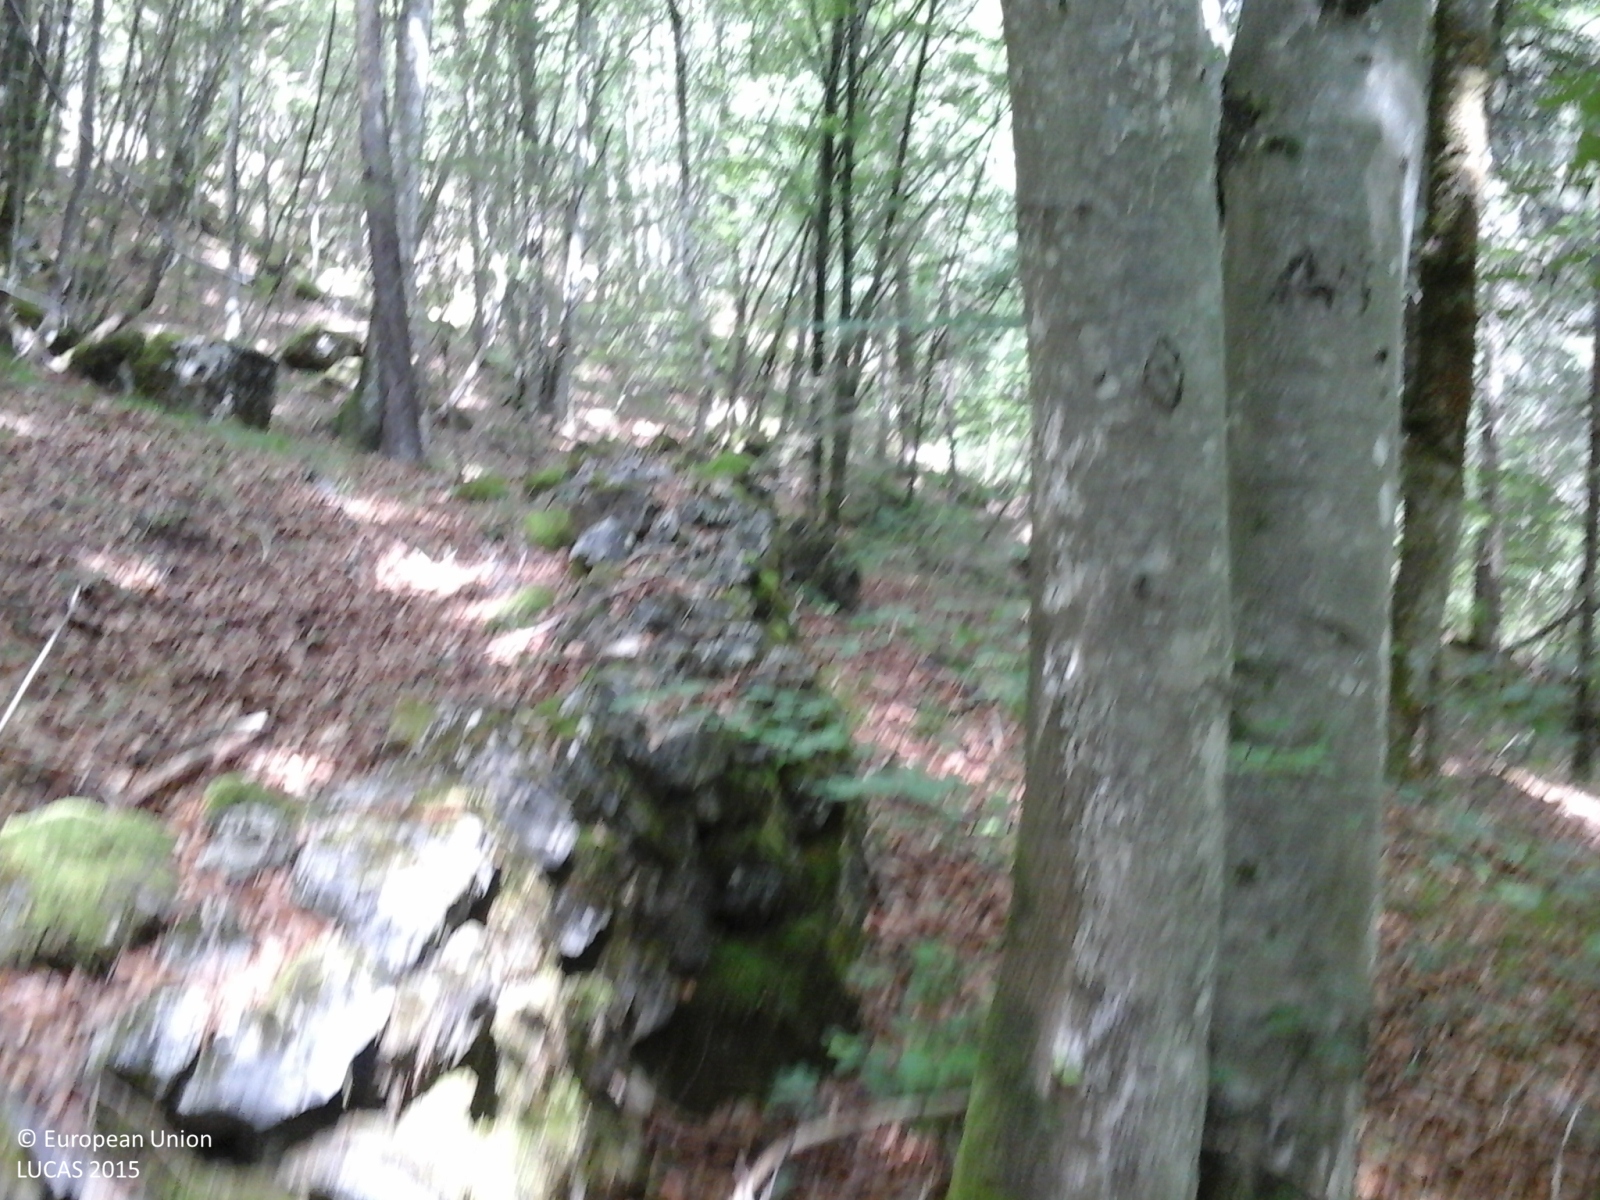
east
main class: Woodland
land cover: Other mixed woodland
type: mountainous beech forest
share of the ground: > 75 %
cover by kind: broadleaved forest trees 70 %, coniferous forest trees 30 %
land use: Semi-natural and natural areas not in use
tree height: > 5 m
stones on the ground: 25 - 50 %
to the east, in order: Other mixed woodland
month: June
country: IT
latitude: 46.2973
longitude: 11.9579
